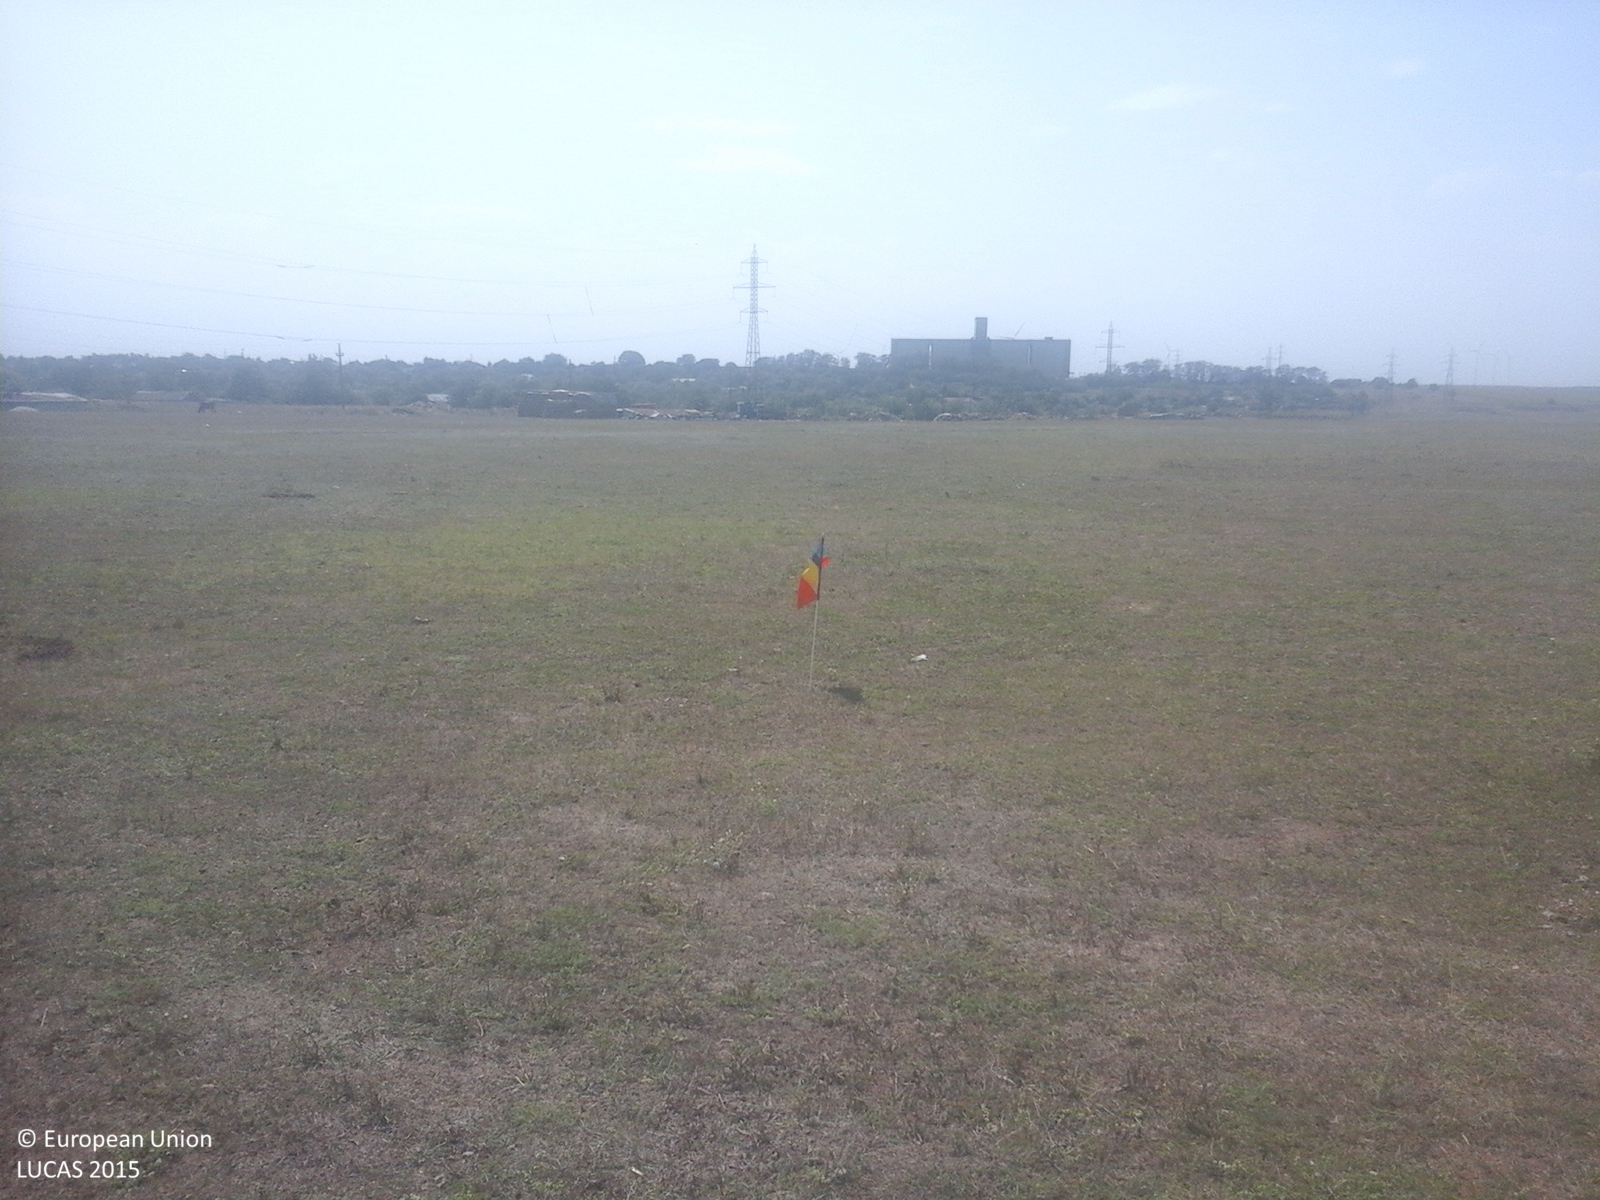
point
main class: Grassland
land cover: Grassland without tree/shrub cover
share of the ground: > 75 %
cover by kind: herbaceous plants 100 %
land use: Agriculture (excluding fallow land and kitchen gardens)
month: August
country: RO
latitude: 44.1104
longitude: 28.2912
